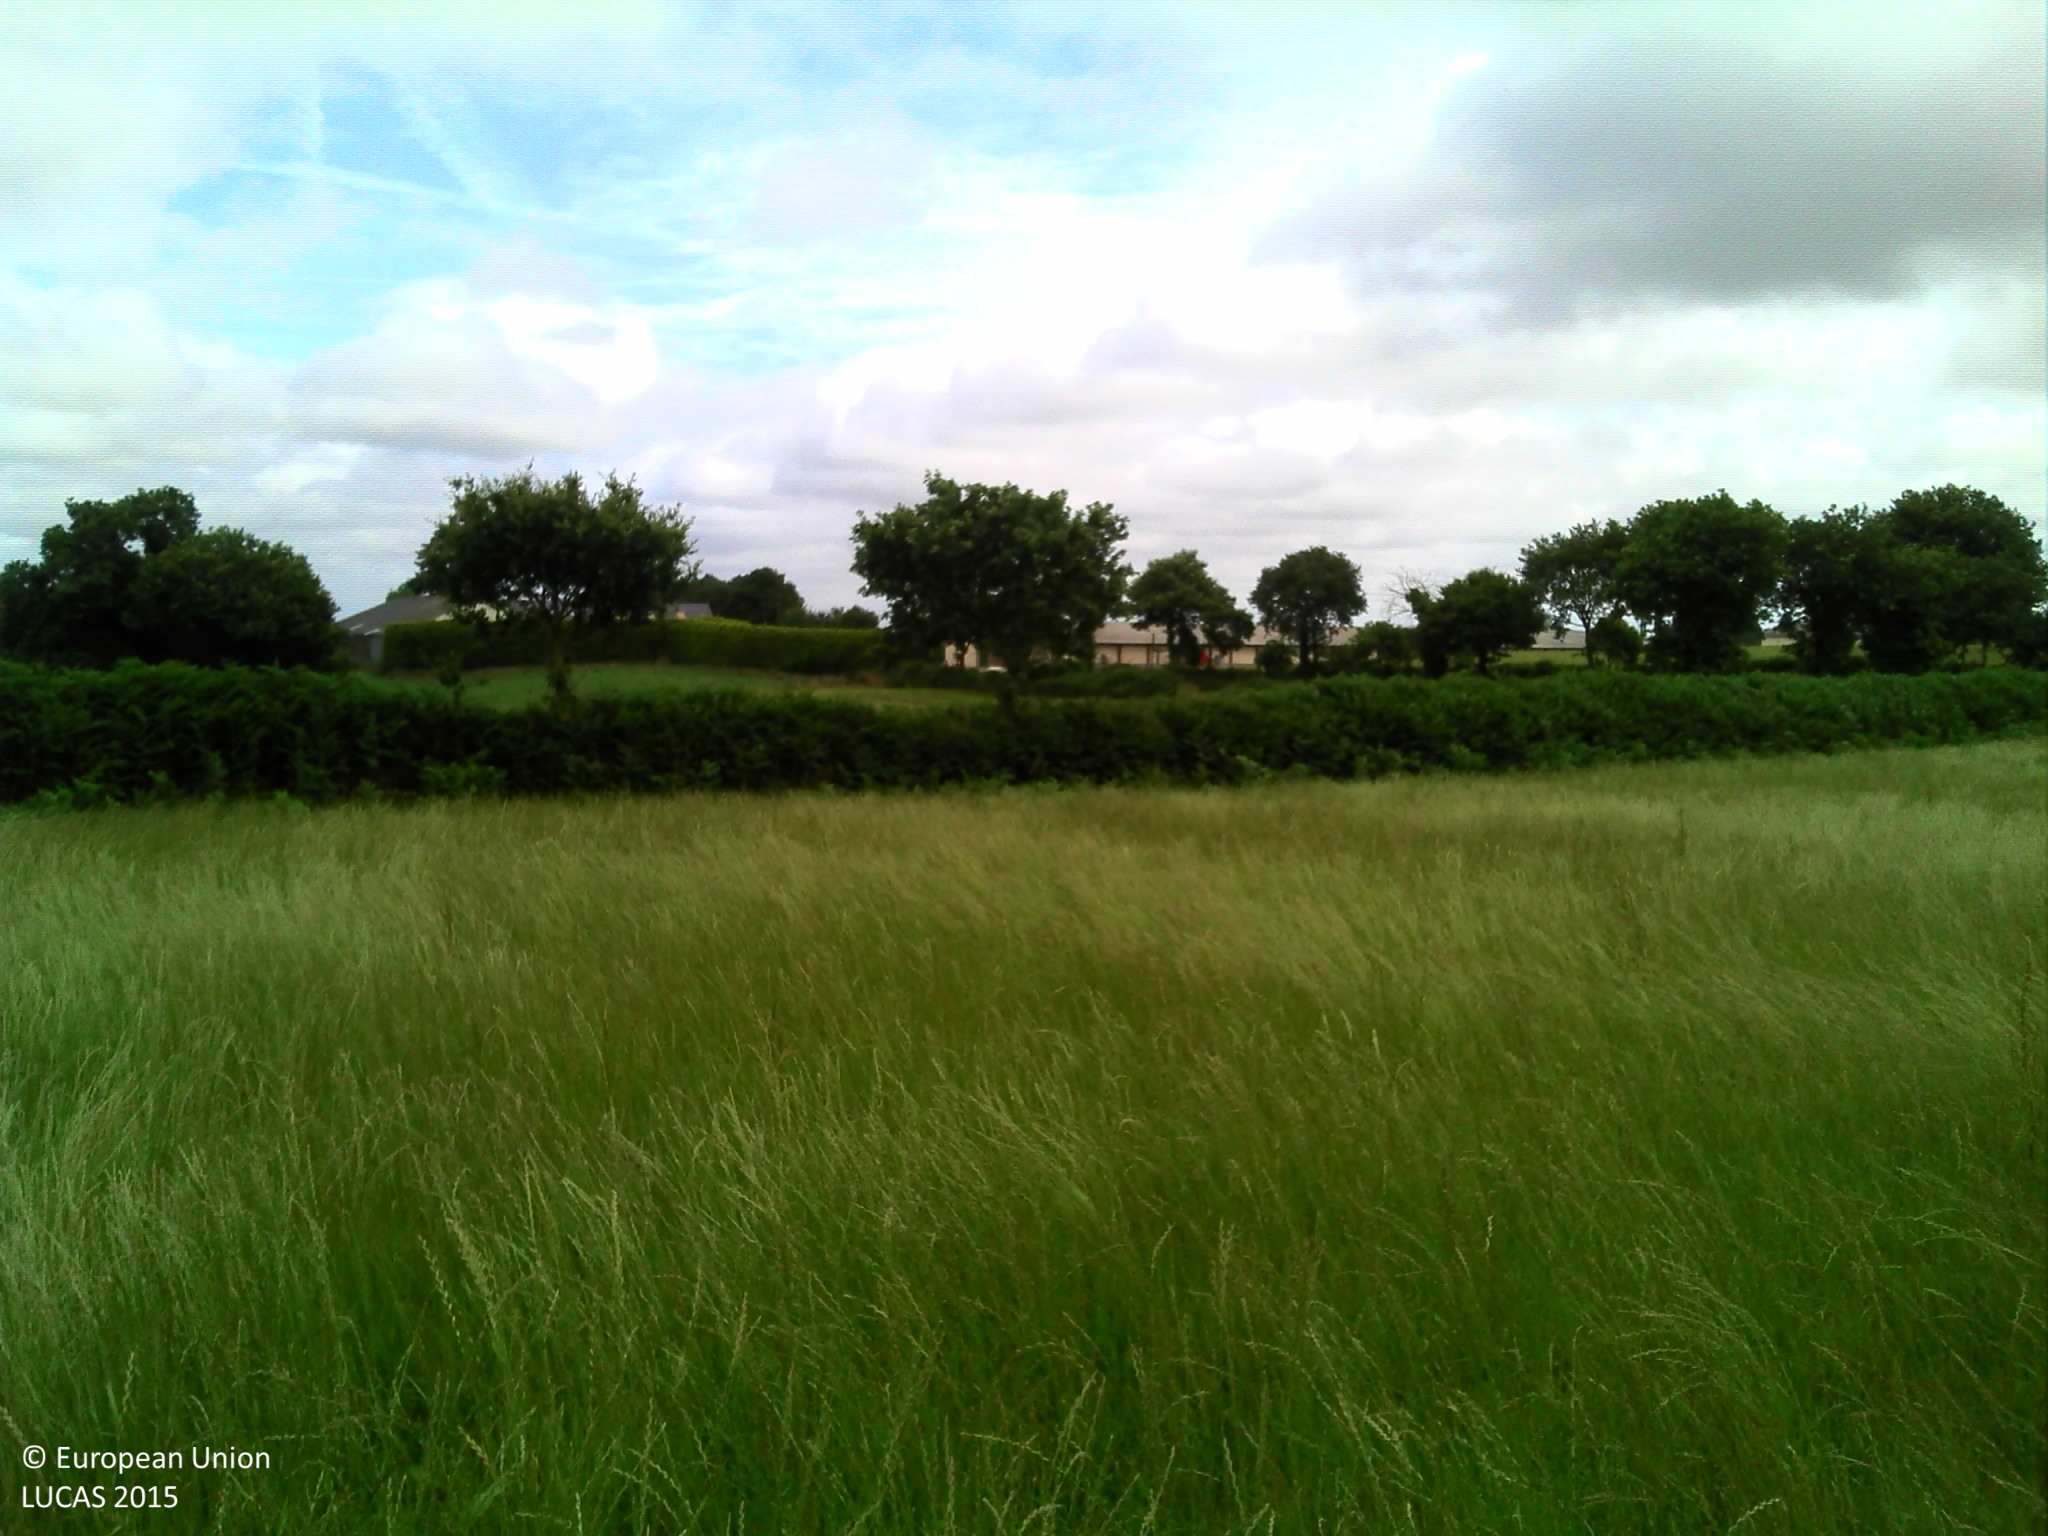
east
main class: Grassland
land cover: Grassland without tree/shrub cover
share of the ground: > 75 %
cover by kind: herbaceous plants 100 %
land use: Agriculture (excluding fallow land and kitchen gardens)
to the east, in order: Grassland without tree/shrub cover; Abandoned hedges; Tracks; Abandoned hedges; Temporary grasslands
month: August
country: FR
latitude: 48.3885
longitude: -3.0753
